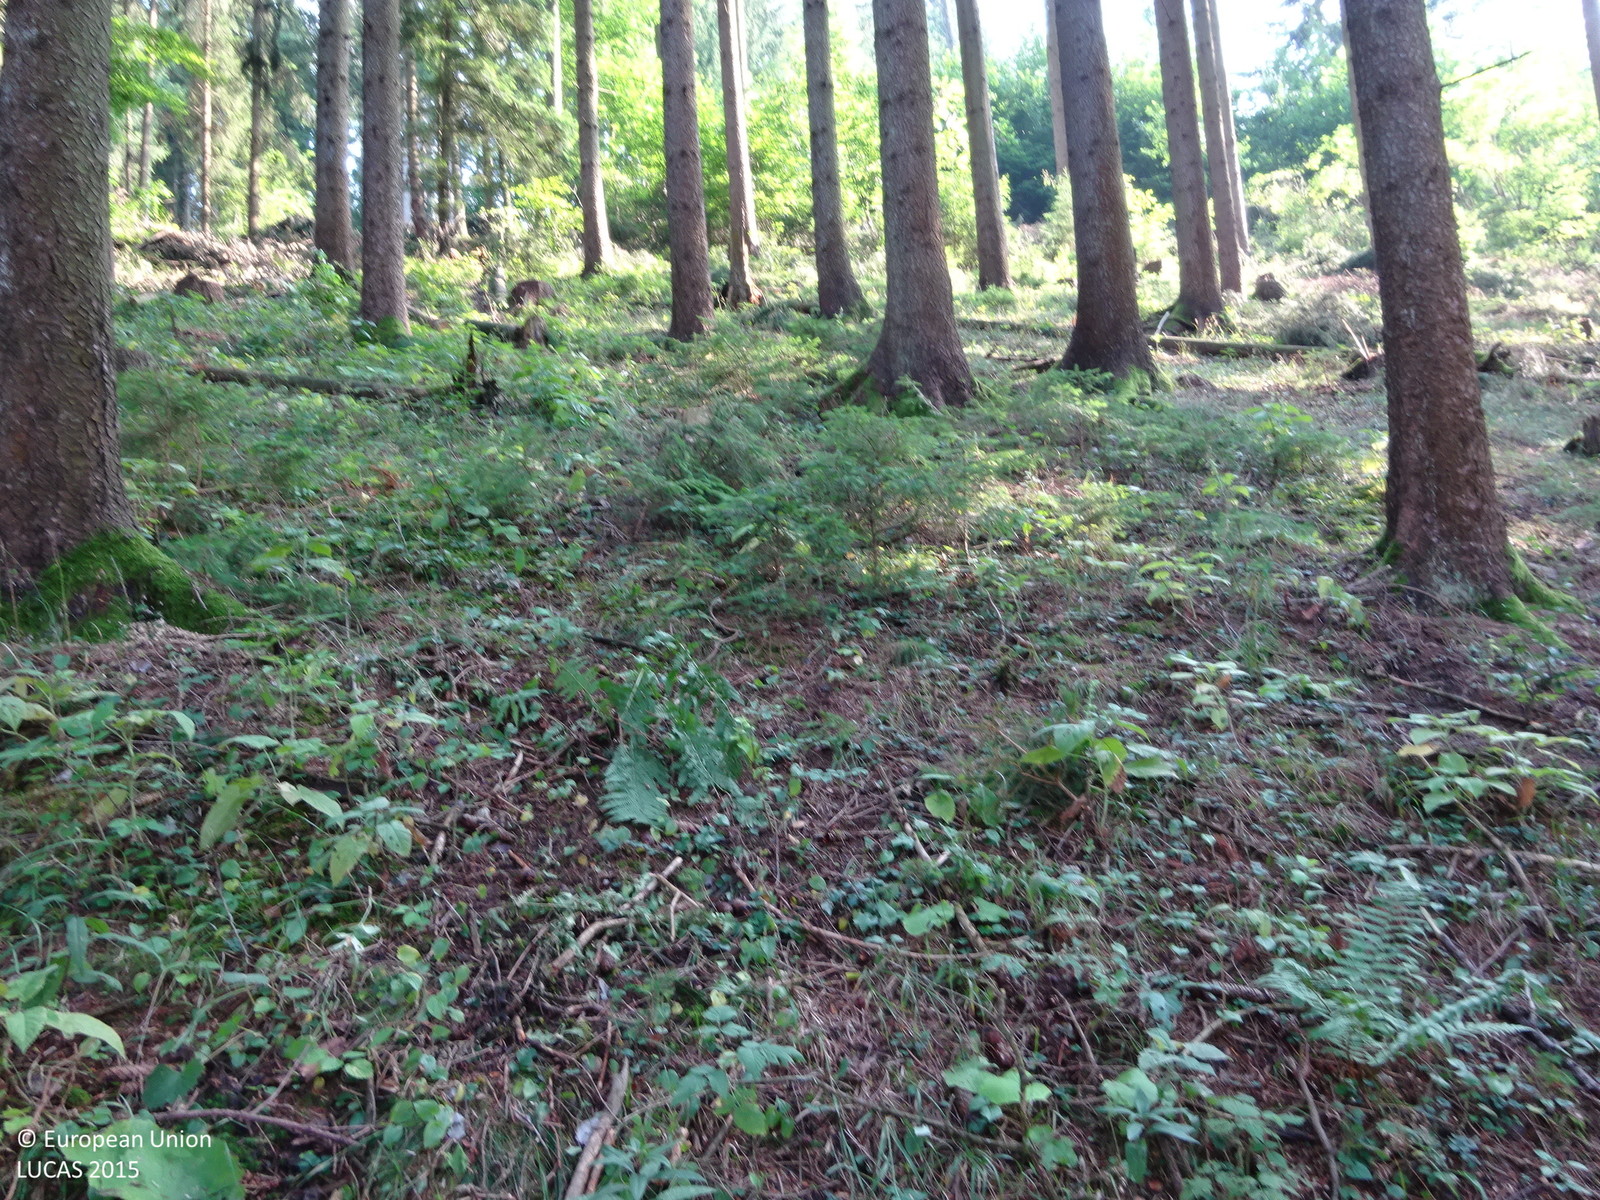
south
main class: Woodland
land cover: Spruce dominated coniferous woodland
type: alpine coniferous forest
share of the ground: > 75 %
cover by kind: coniferous forest trees 90 %, herbaceous plants 5 %, lichens and mosses 5 %
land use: Forestry
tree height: > 5 m
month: August
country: AT
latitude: 47.3375
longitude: 15.6786
